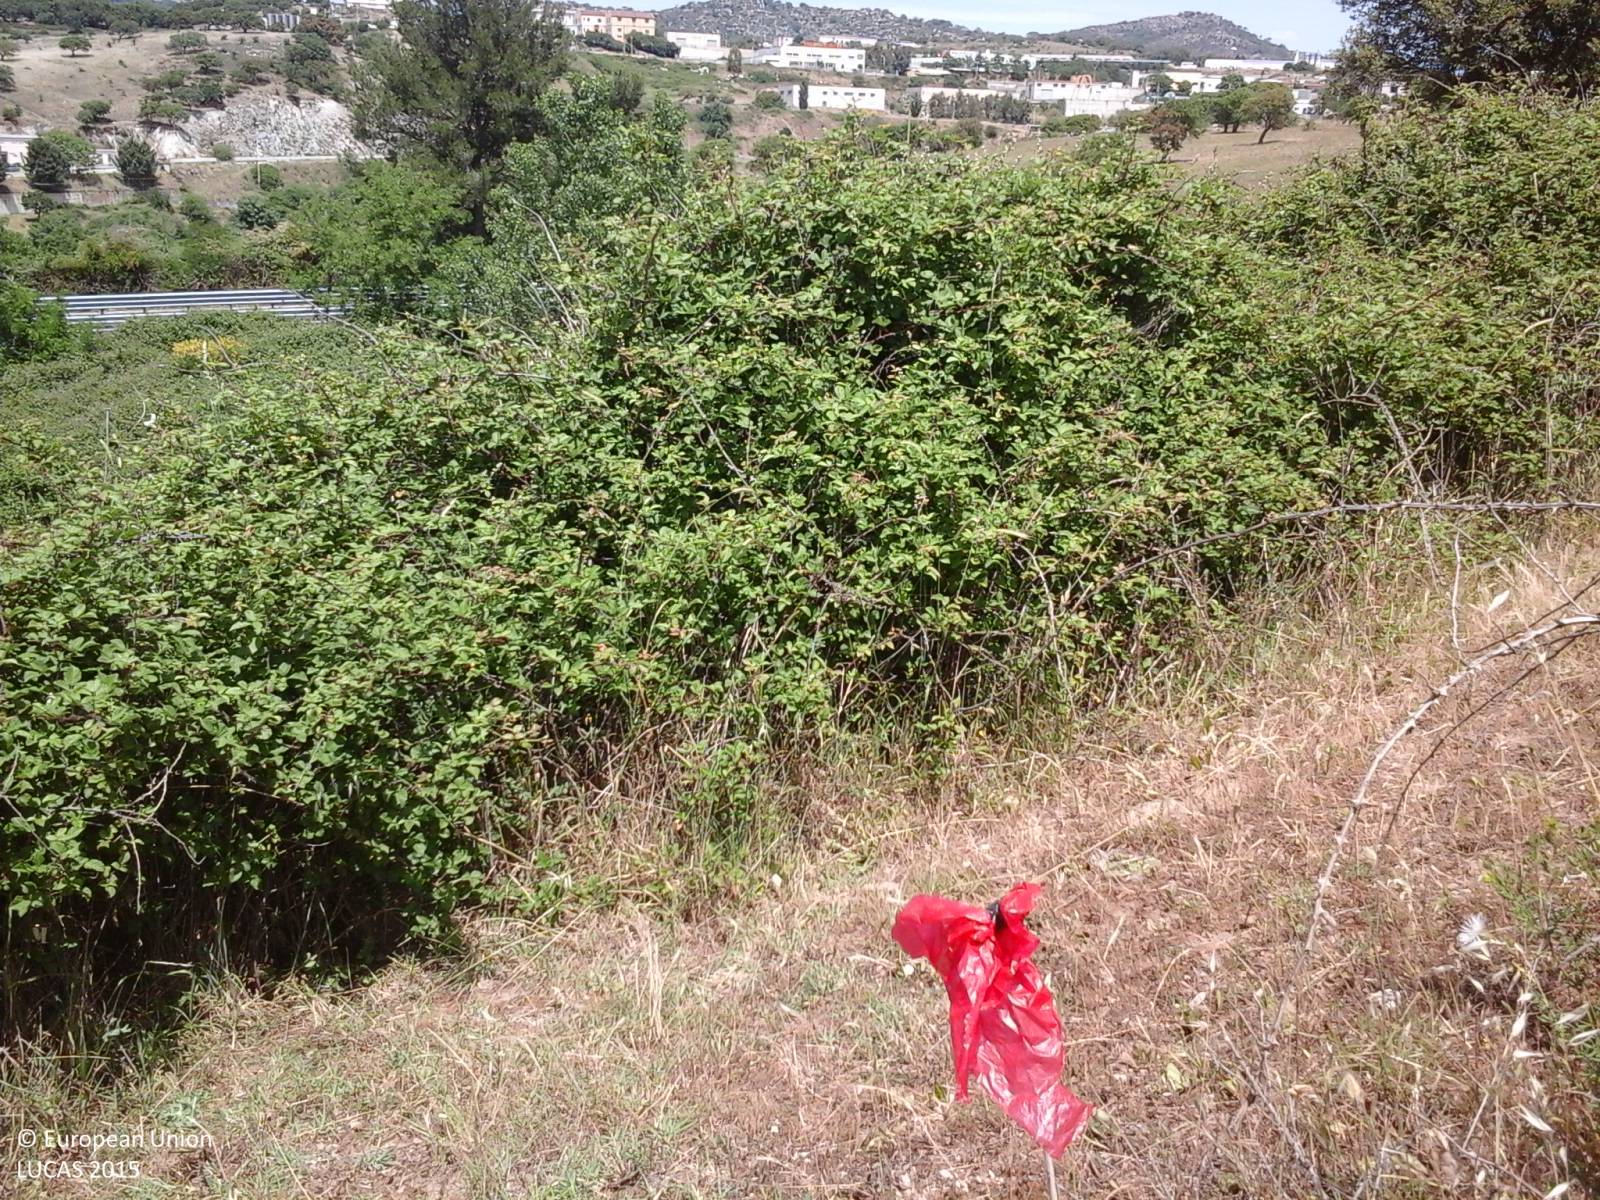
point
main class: Shrubland
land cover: Shrubland without tree cover
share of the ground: > 75 %
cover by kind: herbaceous plants 55 %, shrubs 40 %, unconsolidated bare surface 5 %
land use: Agriculture (excluding fallow land and kitchen gardens)
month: May
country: IT
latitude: 40.3189
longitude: 9.2625
